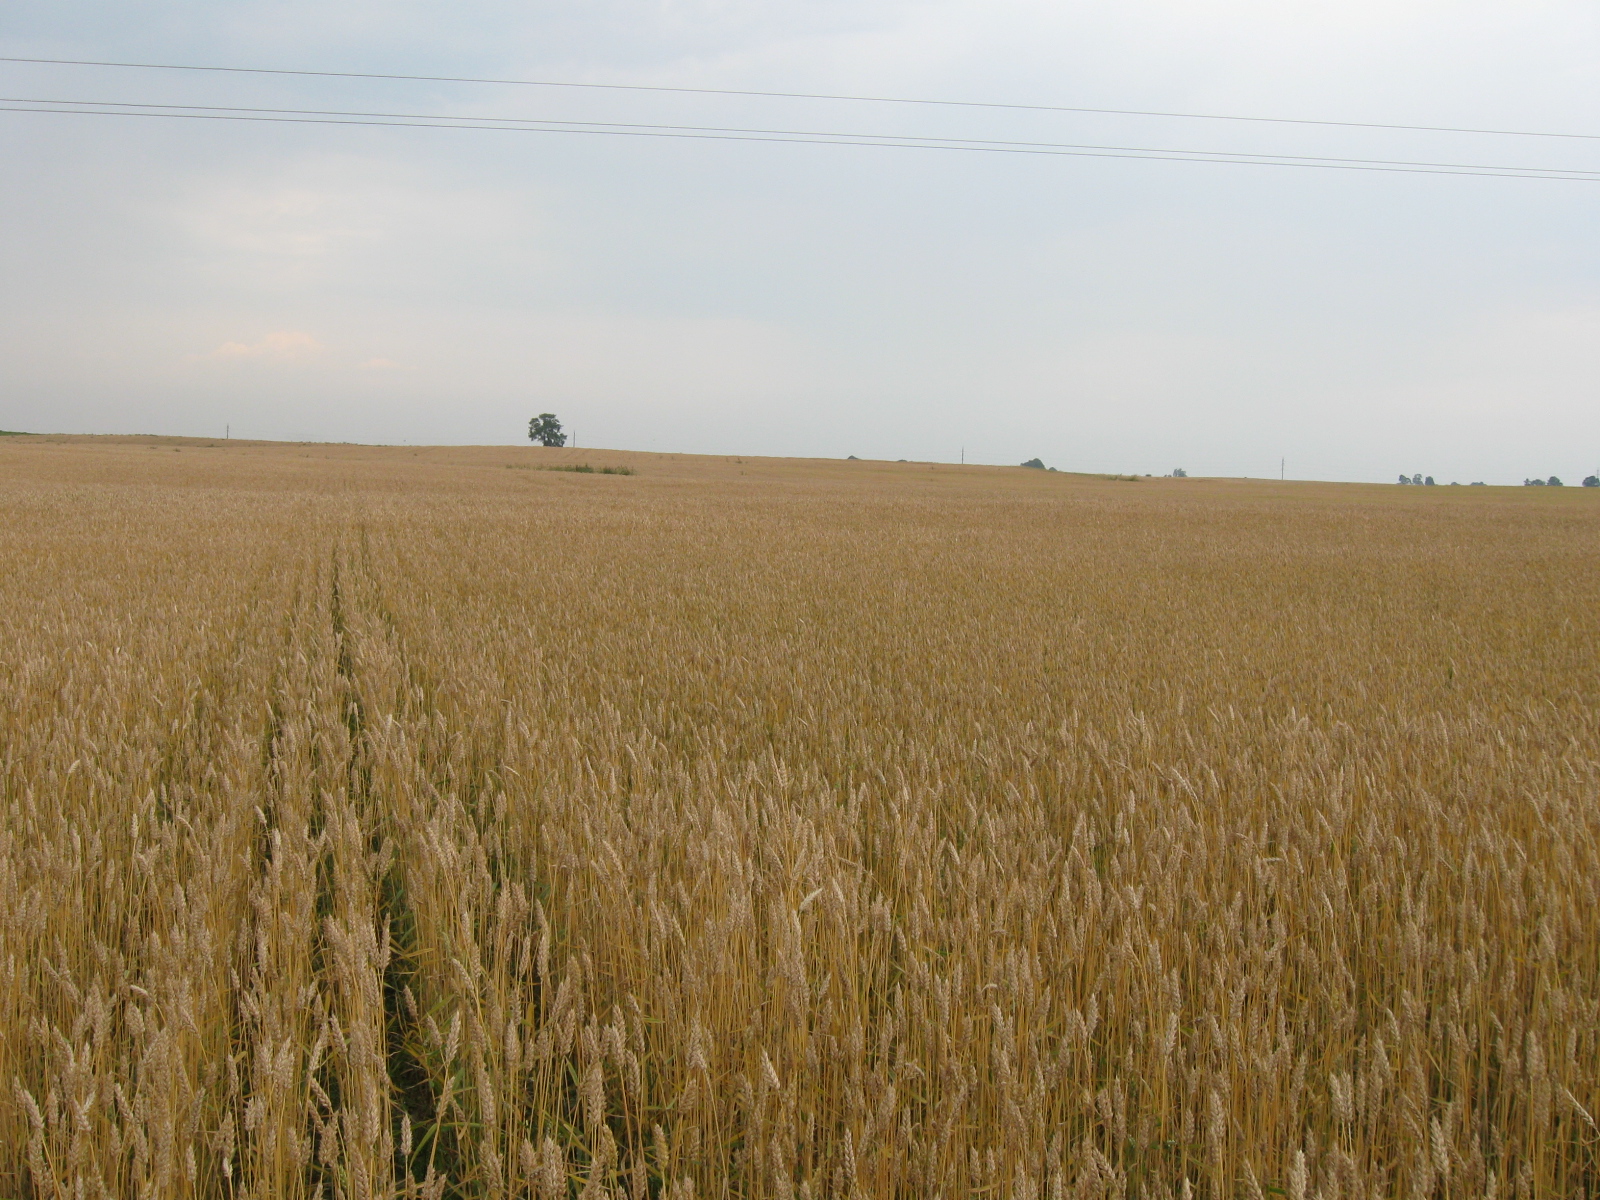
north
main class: Cropland
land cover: Common wheat
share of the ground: > 75 %
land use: Agriculture (excluding fallow land and kitchen gardens)
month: August
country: LT
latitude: 54.5585
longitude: 23.4884
